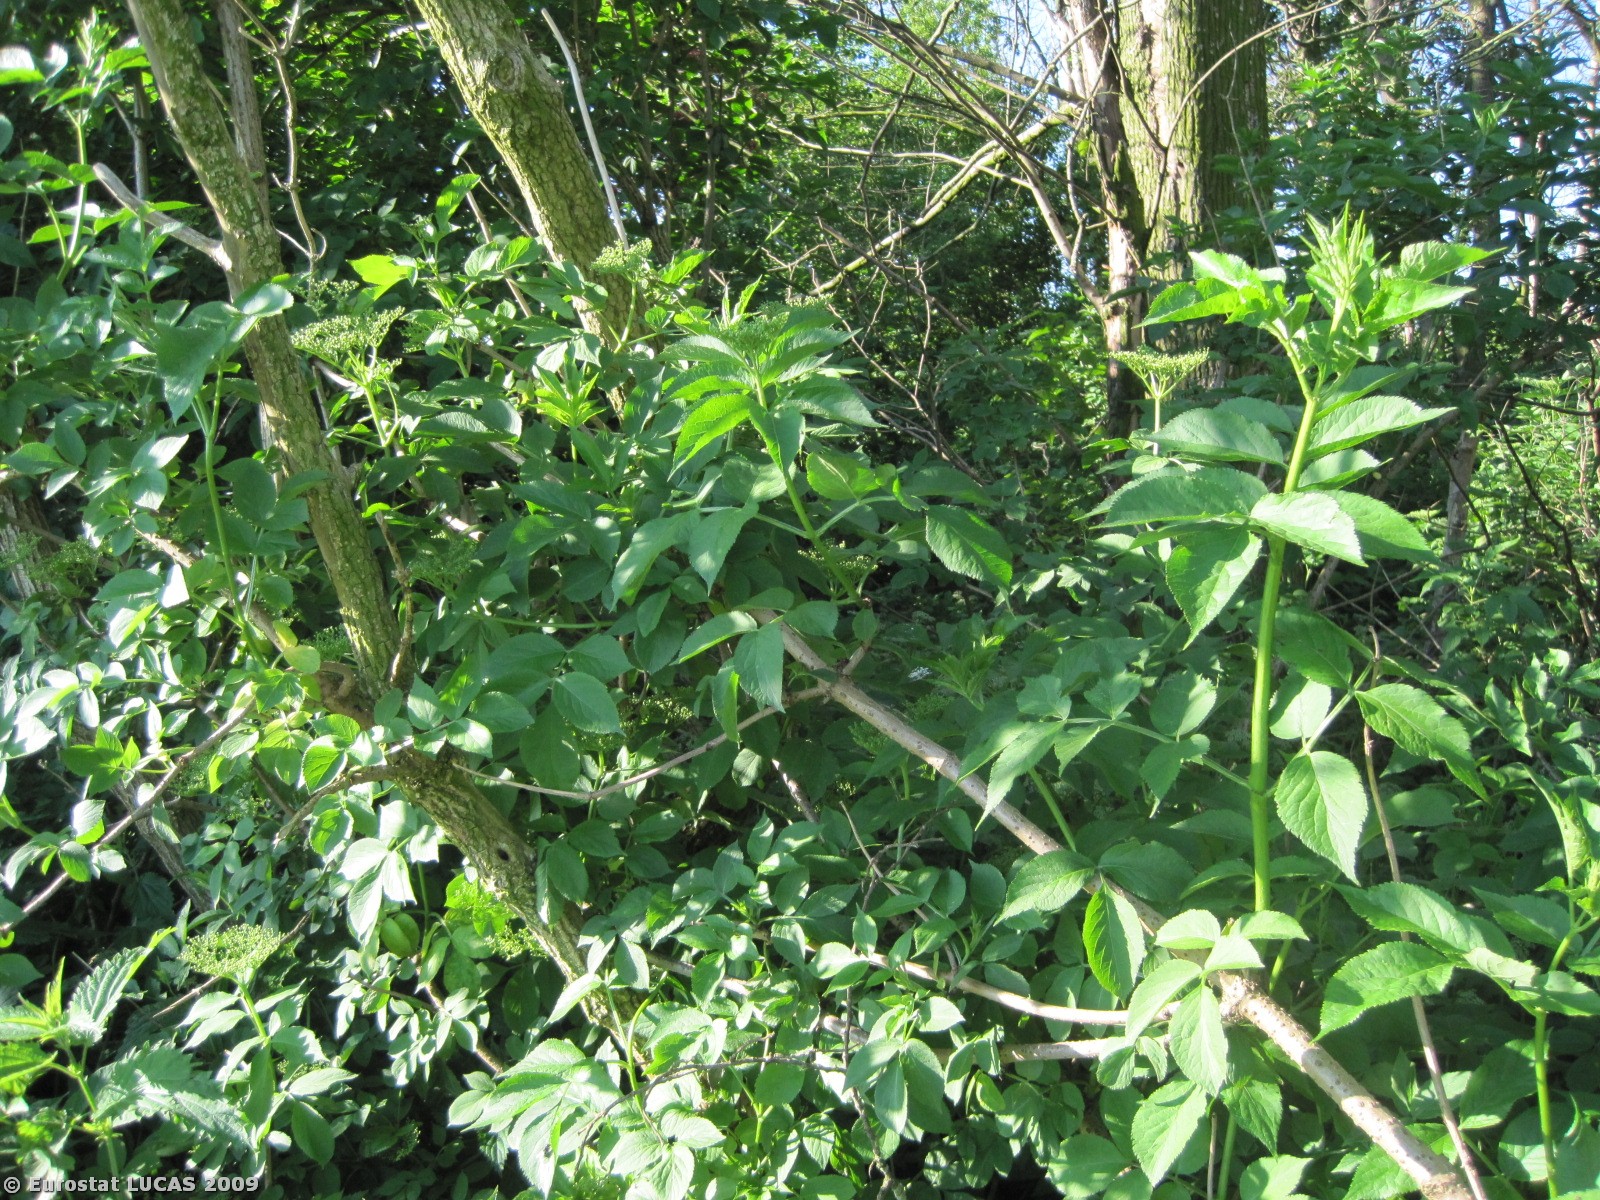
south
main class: Woodland
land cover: Broadleaved woodland
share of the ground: > 75 %
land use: Residential
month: June
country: DK
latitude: 57.4821
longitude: 9.8834
